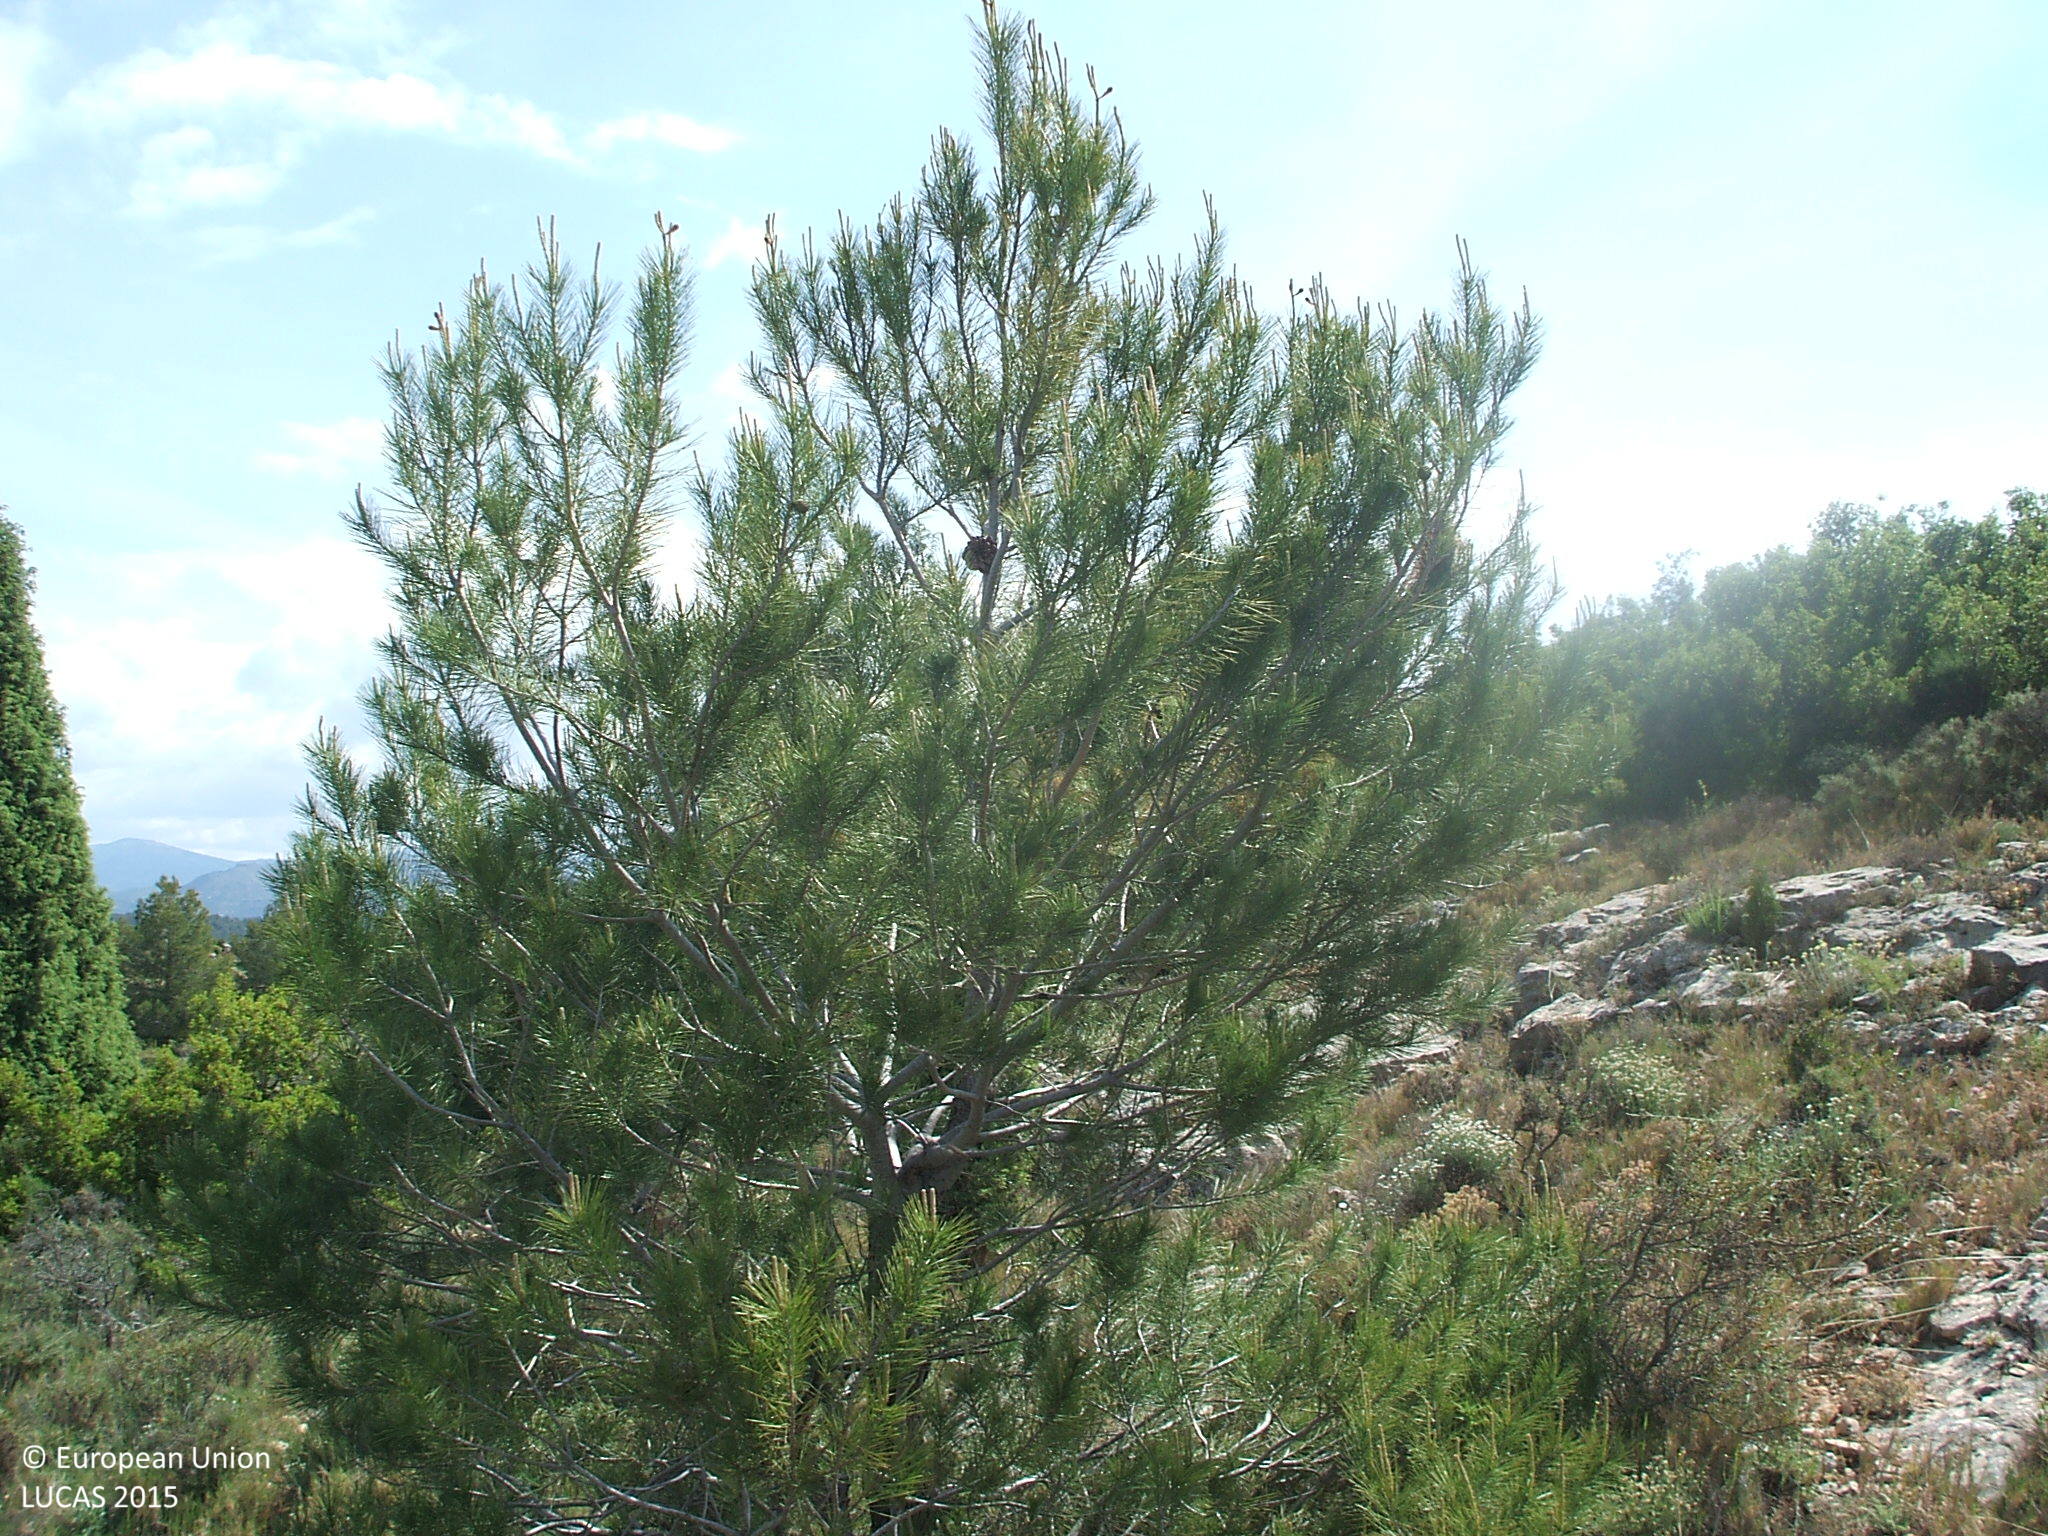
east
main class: Shrubland
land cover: Shrubland with sparse tree cover
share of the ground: > 75 %
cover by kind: shrubs 90 %, coniferous forest trees 5 %, herbaceous plants 5 %
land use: Semi-natural and natural areas not in use
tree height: > 5 m
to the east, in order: Shrubland with sparse tree cover; Rock outcrops; Abandoned hedges; Paved roads, cycling and walking lanes; Other bare soil; Shrubland without tree cover; Abandoned hedges; Tracks; Abandoned hedges; Dry stone walls; Pine dominated coniferous woodland; Shrubland without tree cover; Shrubland with sparse tree cover; Ditches and canals; Other bare soil
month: May
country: ES
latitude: 40.1187
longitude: -0.6950
